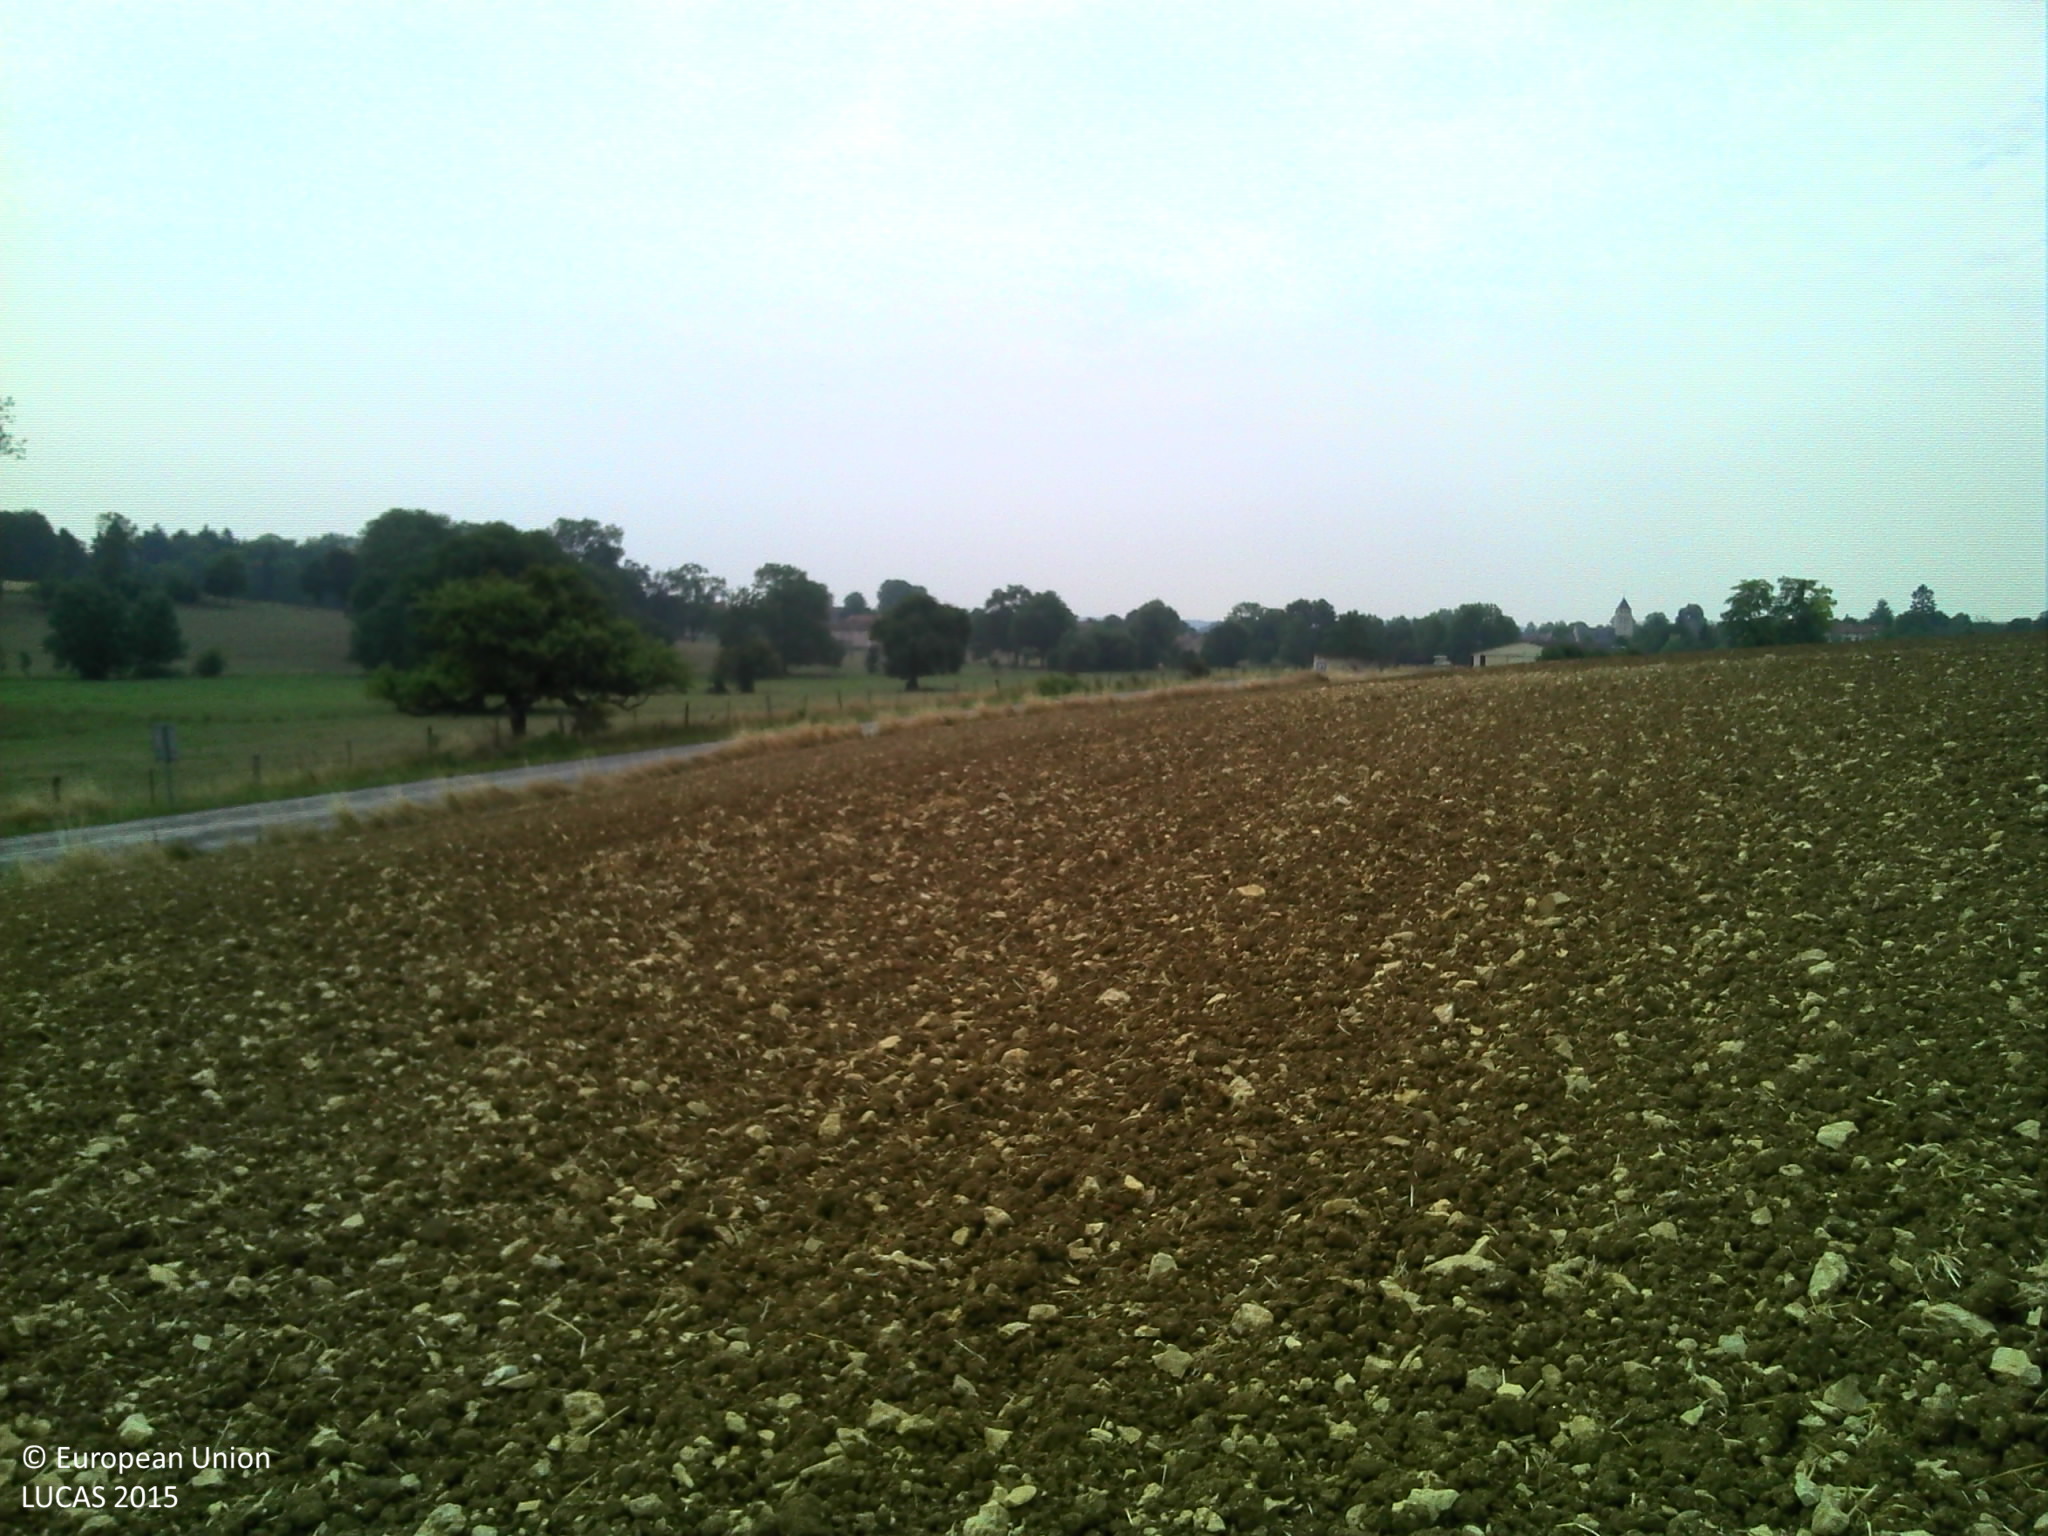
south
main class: Cropland
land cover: Barley
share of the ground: < 10 %
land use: Agriculture (excluding fallow land and kitchen gardens)
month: August
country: FR
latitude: 49.3396
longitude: 5.0845
